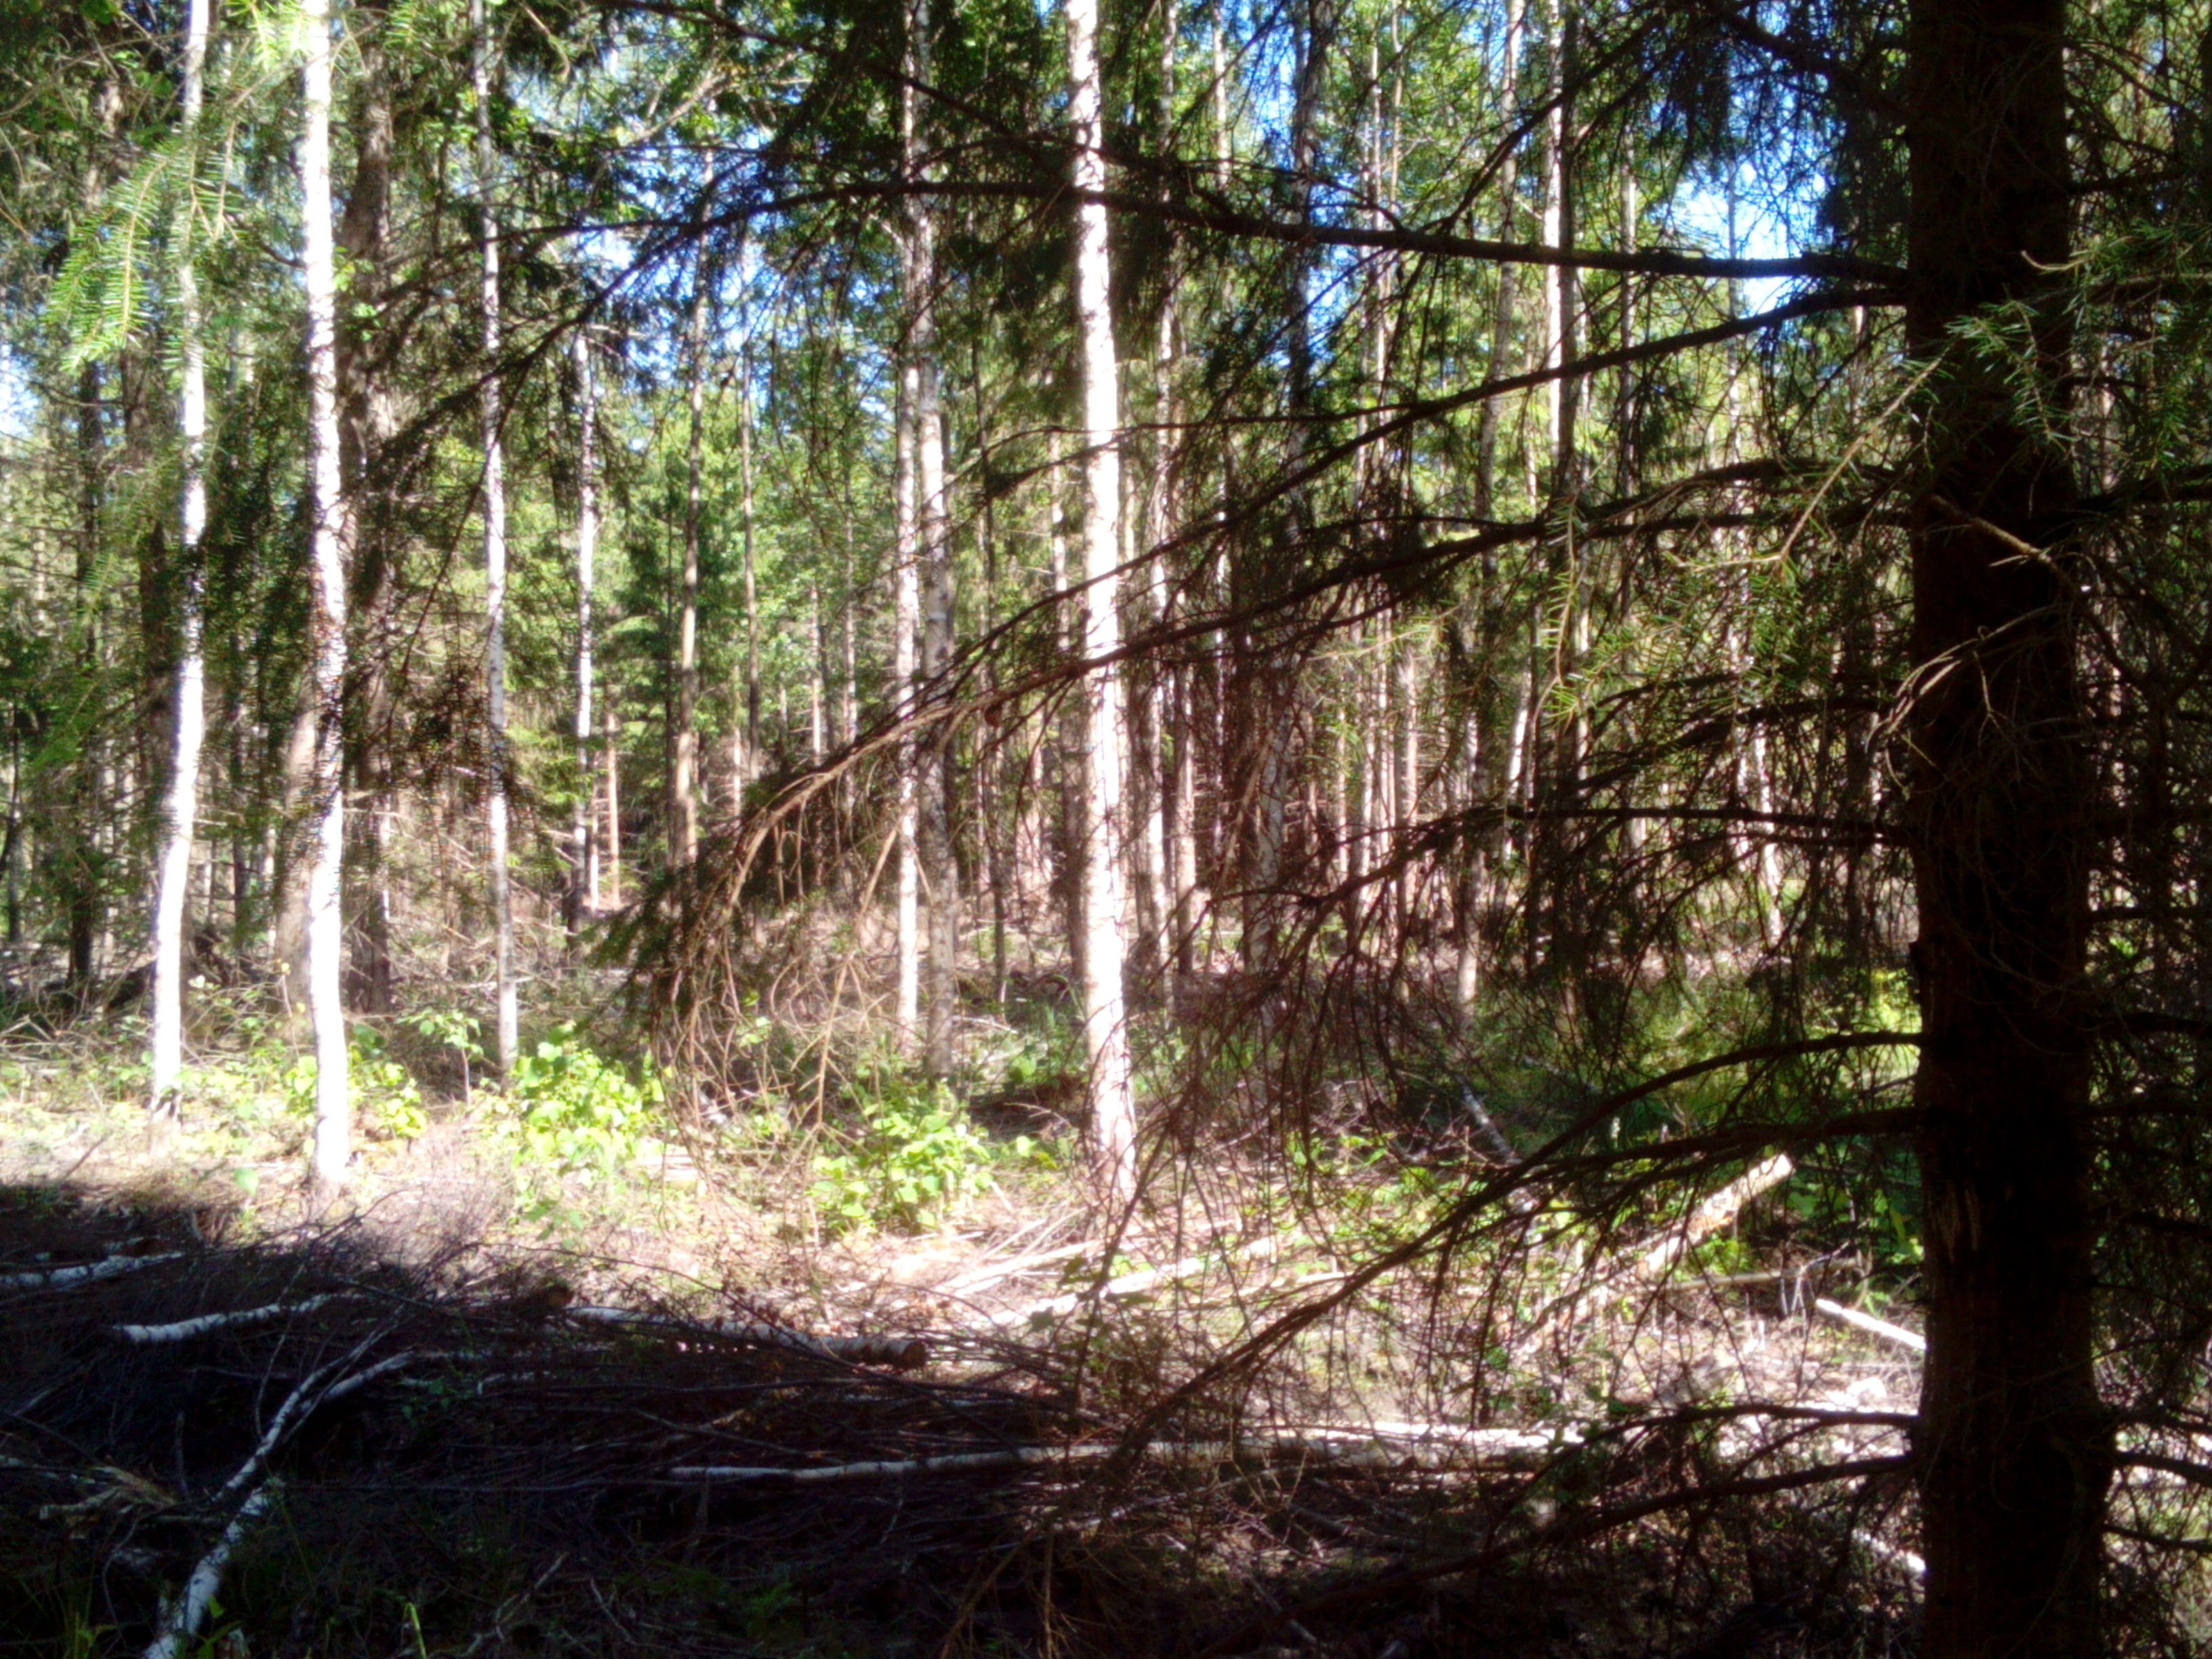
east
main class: Woodland
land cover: Spruce dominated mixed woodland
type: hemiboreal forest and nemoral coniferous forest and mixed broadleaved-coniferous forest
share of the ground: > 75 %
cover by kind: coniferous forest trees 50 %, broadleaved forest trees 35 %, herbaceous plants 5 %, lichens and mosses 5 %, unconsolidated bare surface 5 %
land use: Forestry
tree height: > 5 m
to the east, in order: Spruce dominated mixed woodland; Ditches and canals; Spruce dominated coniferous woodland; Spruce dominated mixed woodland; Spontaneously vegetated surfaces; Spruce dominated mixed woodland
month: July
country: LV
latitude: 56.5586
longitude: 22.1072
